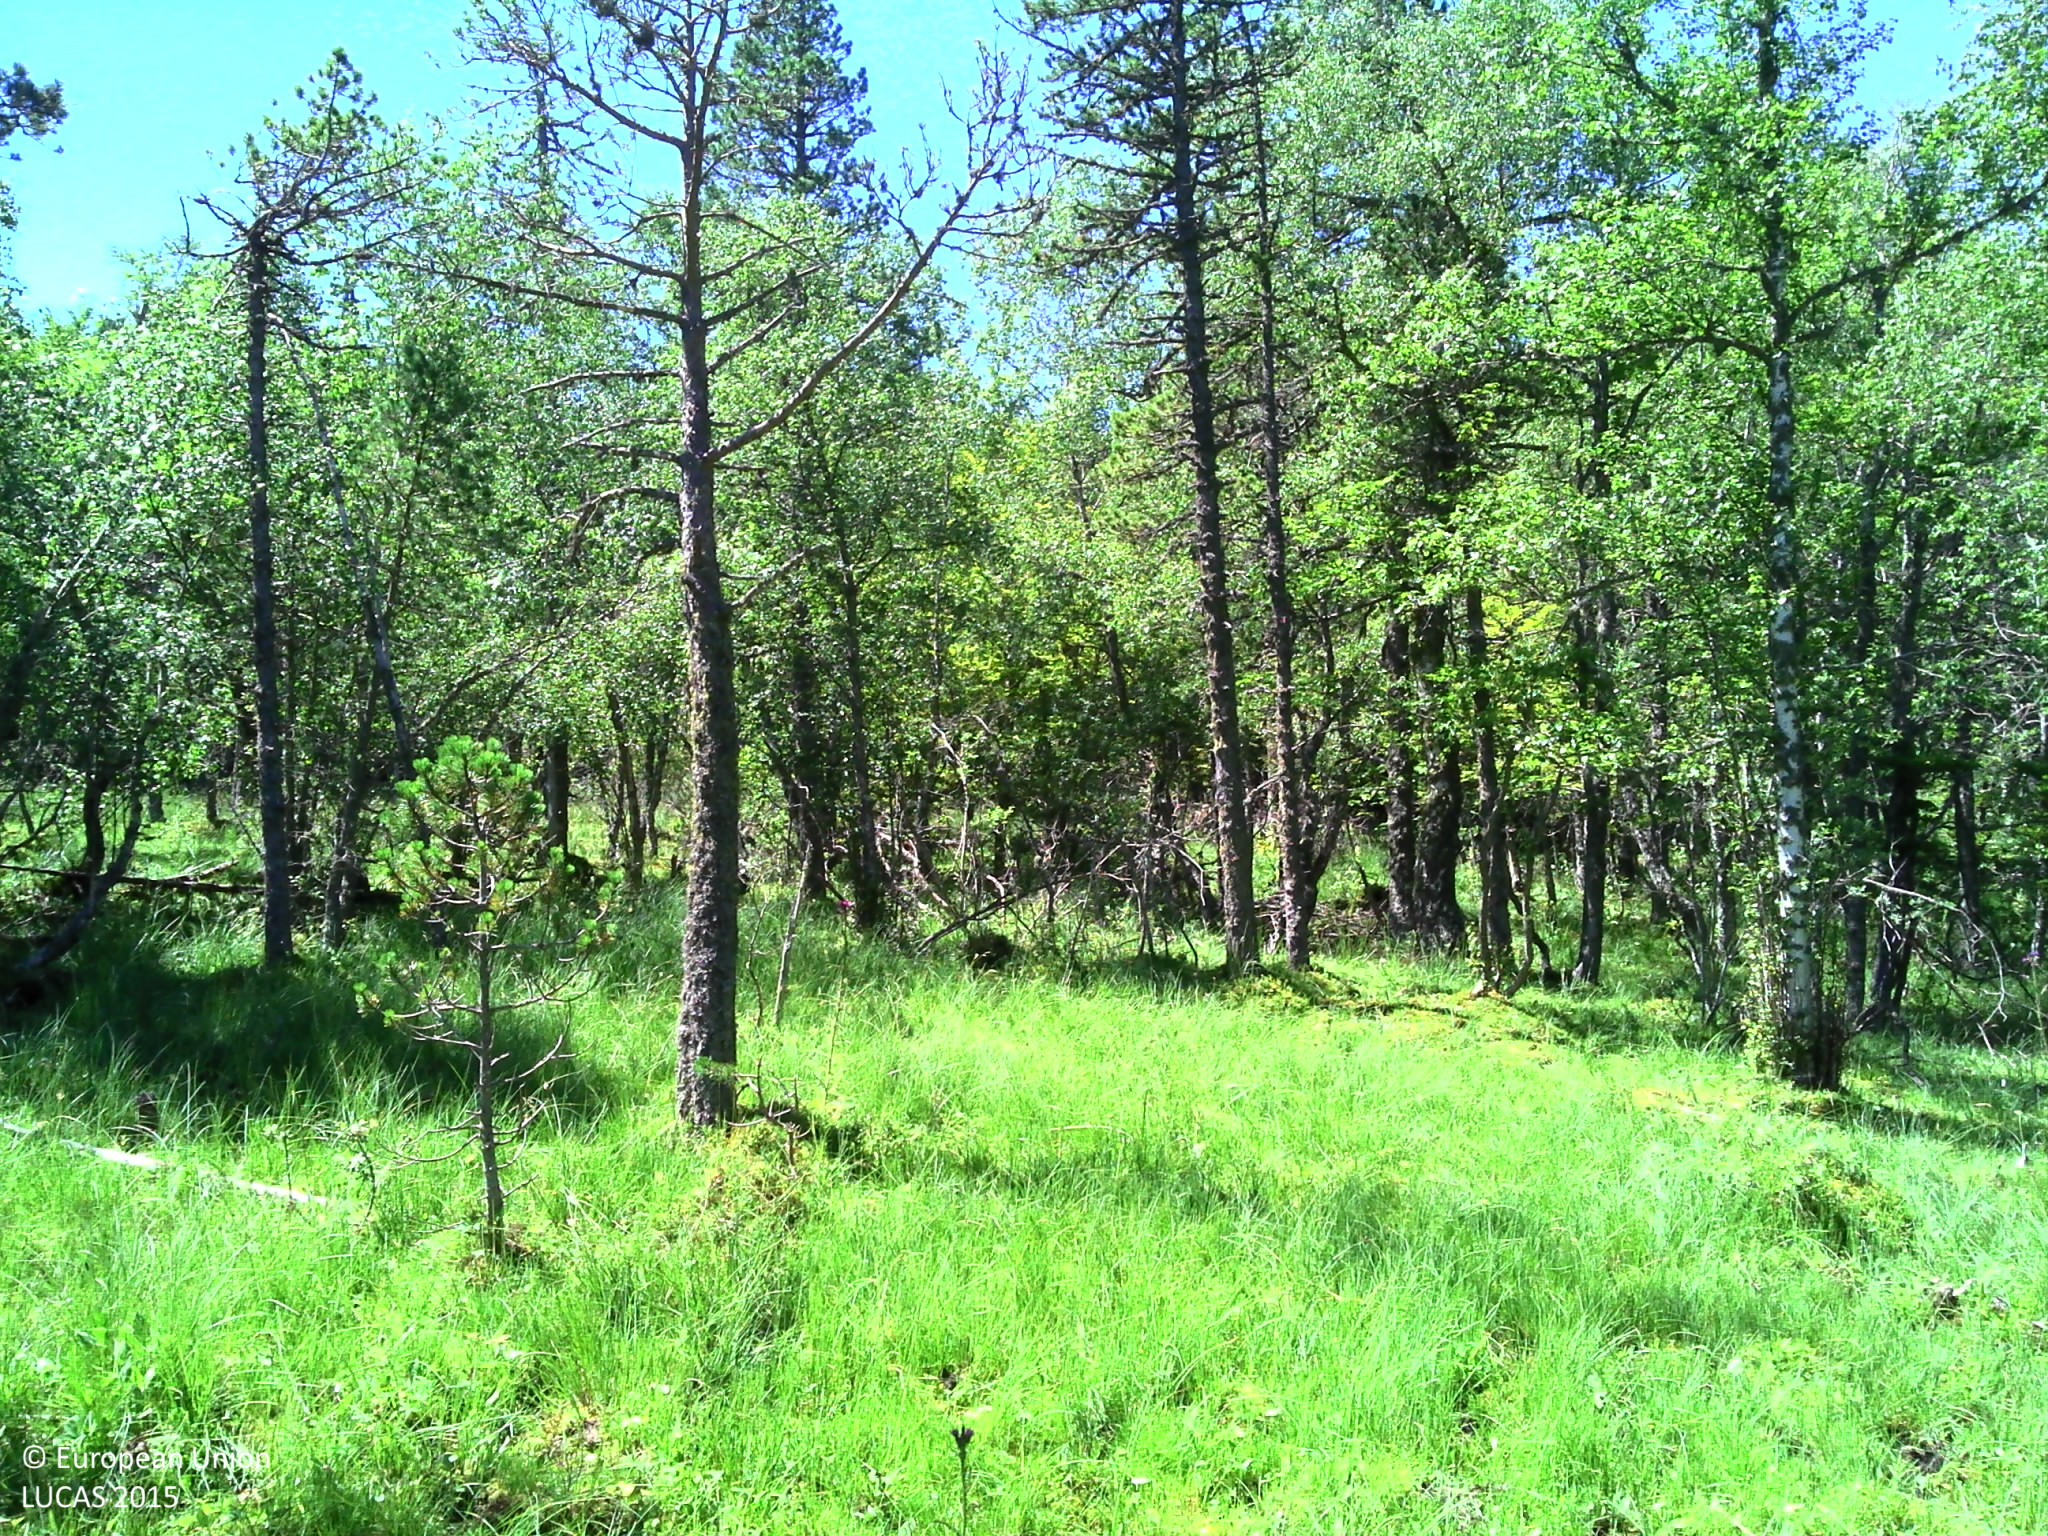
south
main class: Woodland
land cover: Pine dominated mixed woodland
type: hemiboreal forest and nemoral coniferous forest and mixed broadleaved-coniferous forest
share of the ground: > 75 %
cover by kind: broadleaved forest trees 40 %, coniferous forest trees 35 %, herbaceous plants 20 %
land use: Forestry
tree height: > 5 m
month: July
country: FR
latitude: 42.6728
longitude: 2.1155
